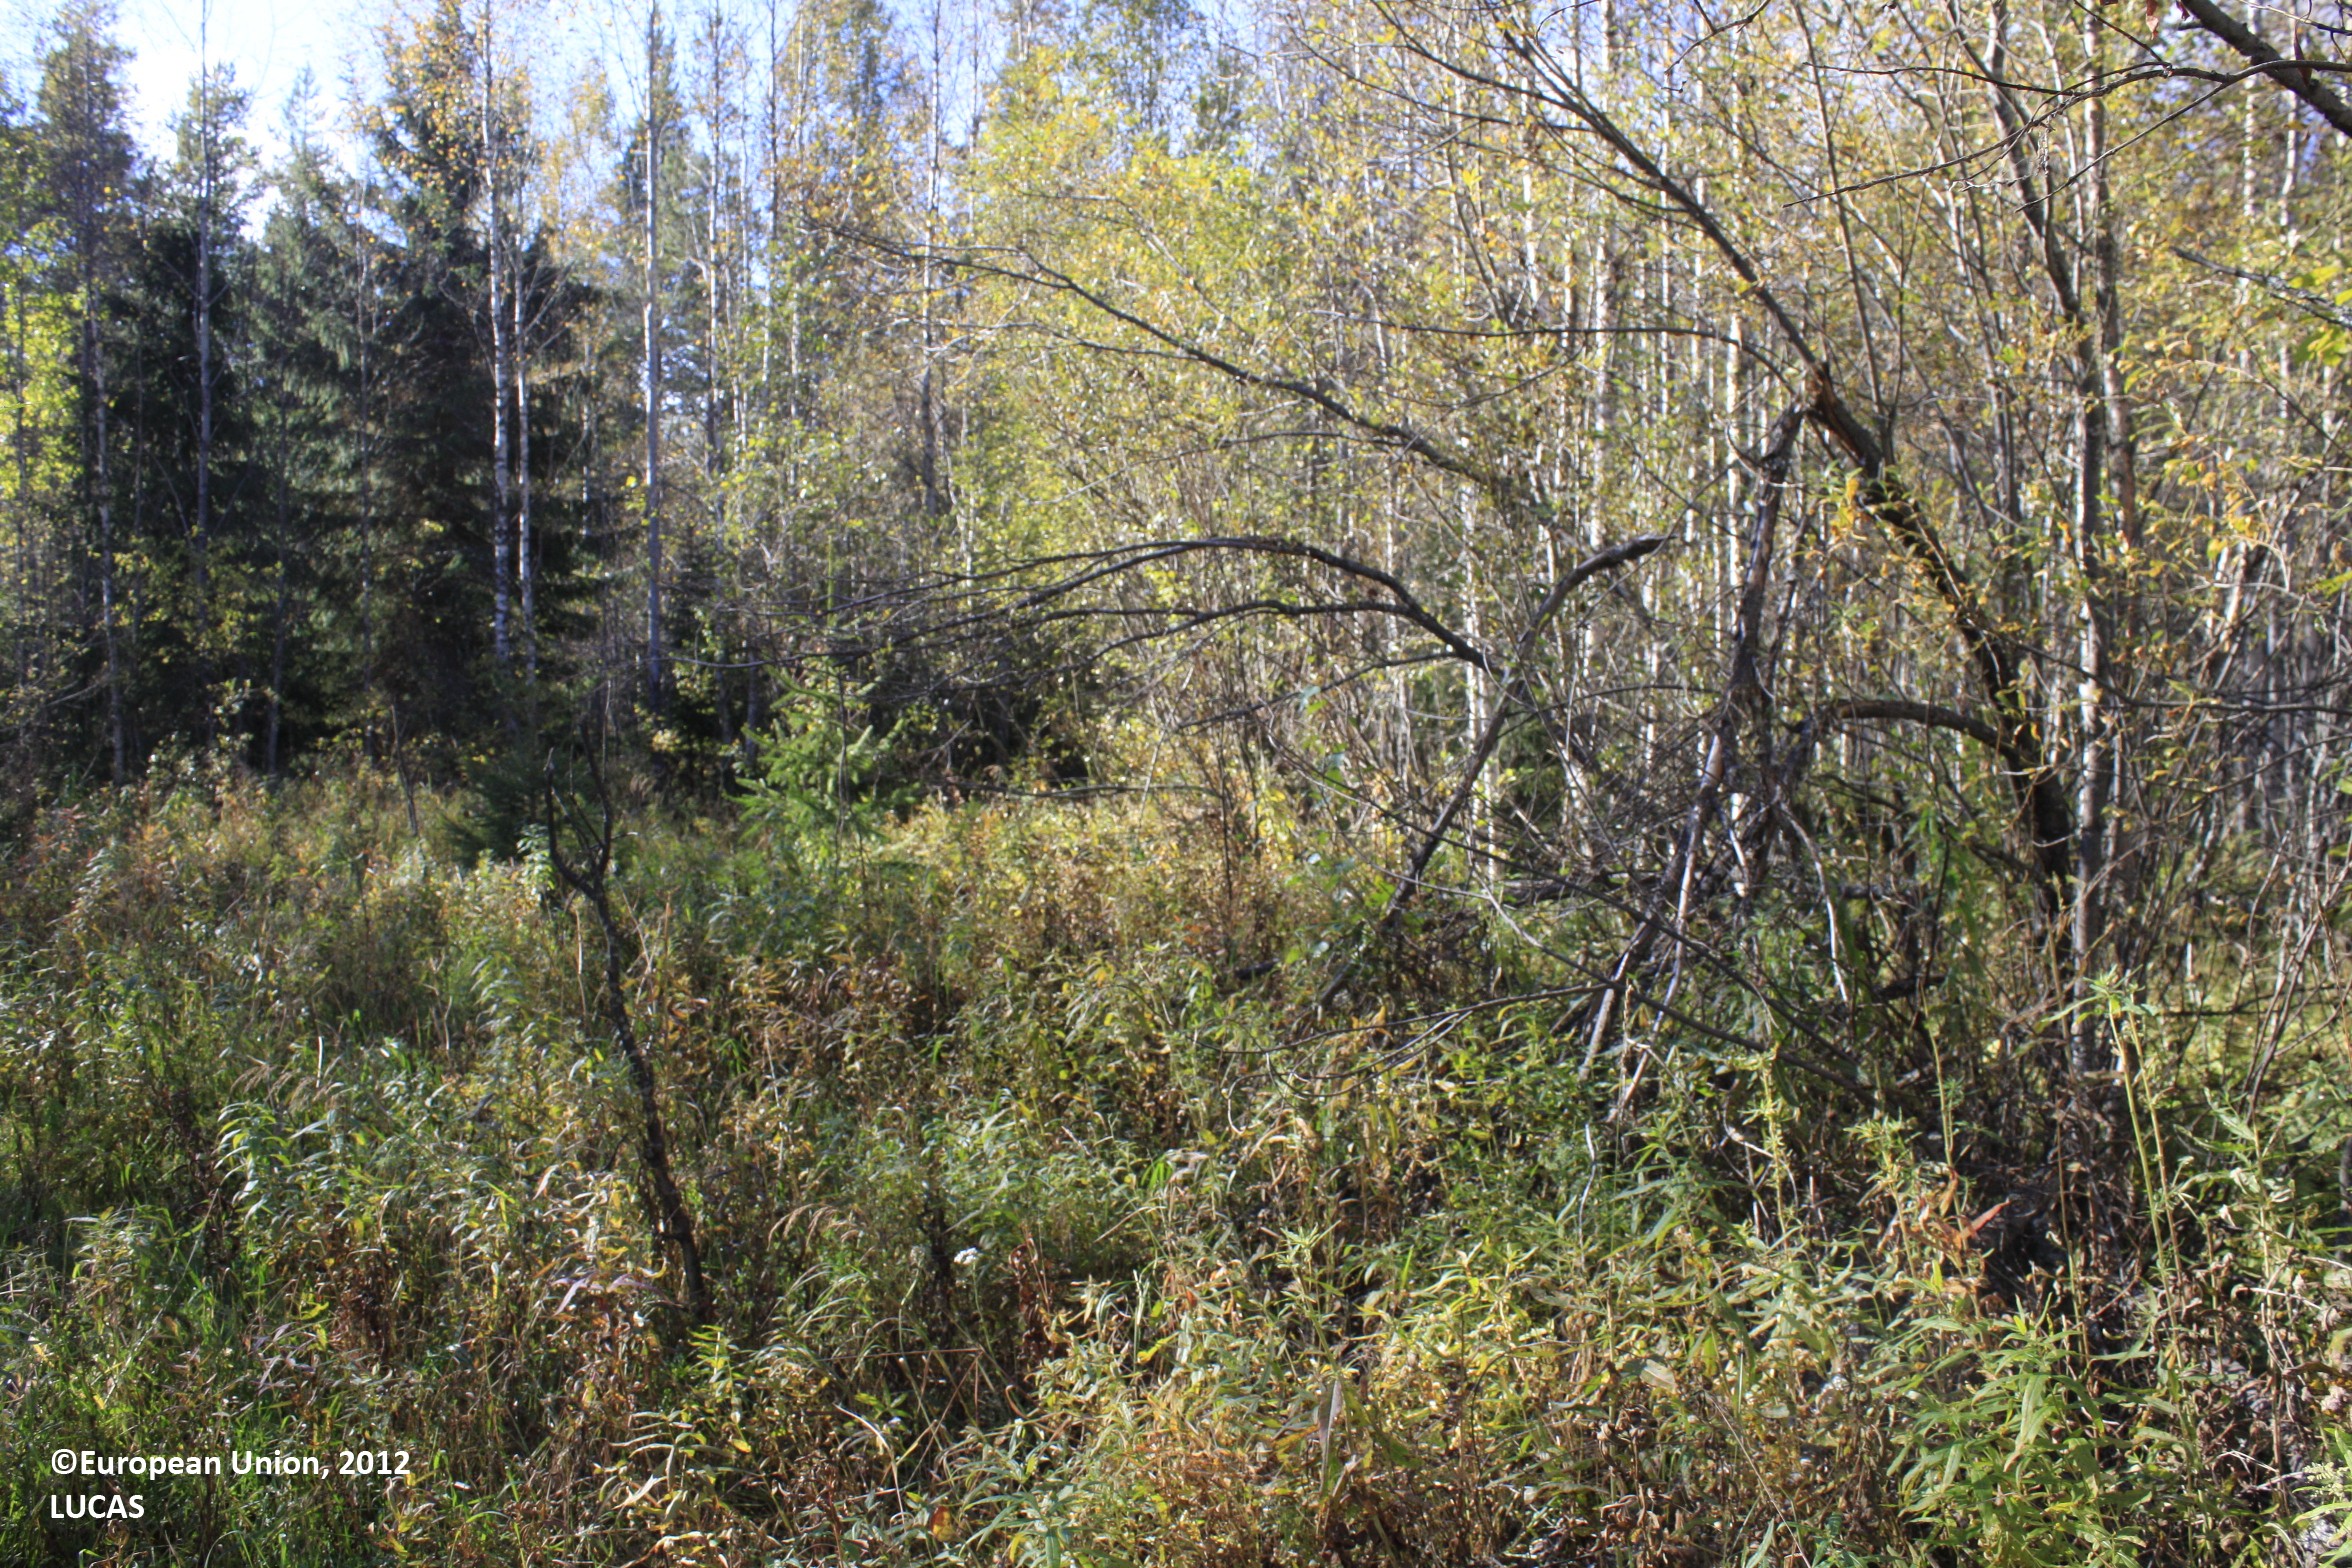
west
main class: Woodland
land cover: Broadleaved woodland
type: boreal forest
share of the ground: 25 - 50 %
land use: Forestry
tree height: > 5 m
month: September
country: FI
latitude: 63.7730
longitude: 25.9074
